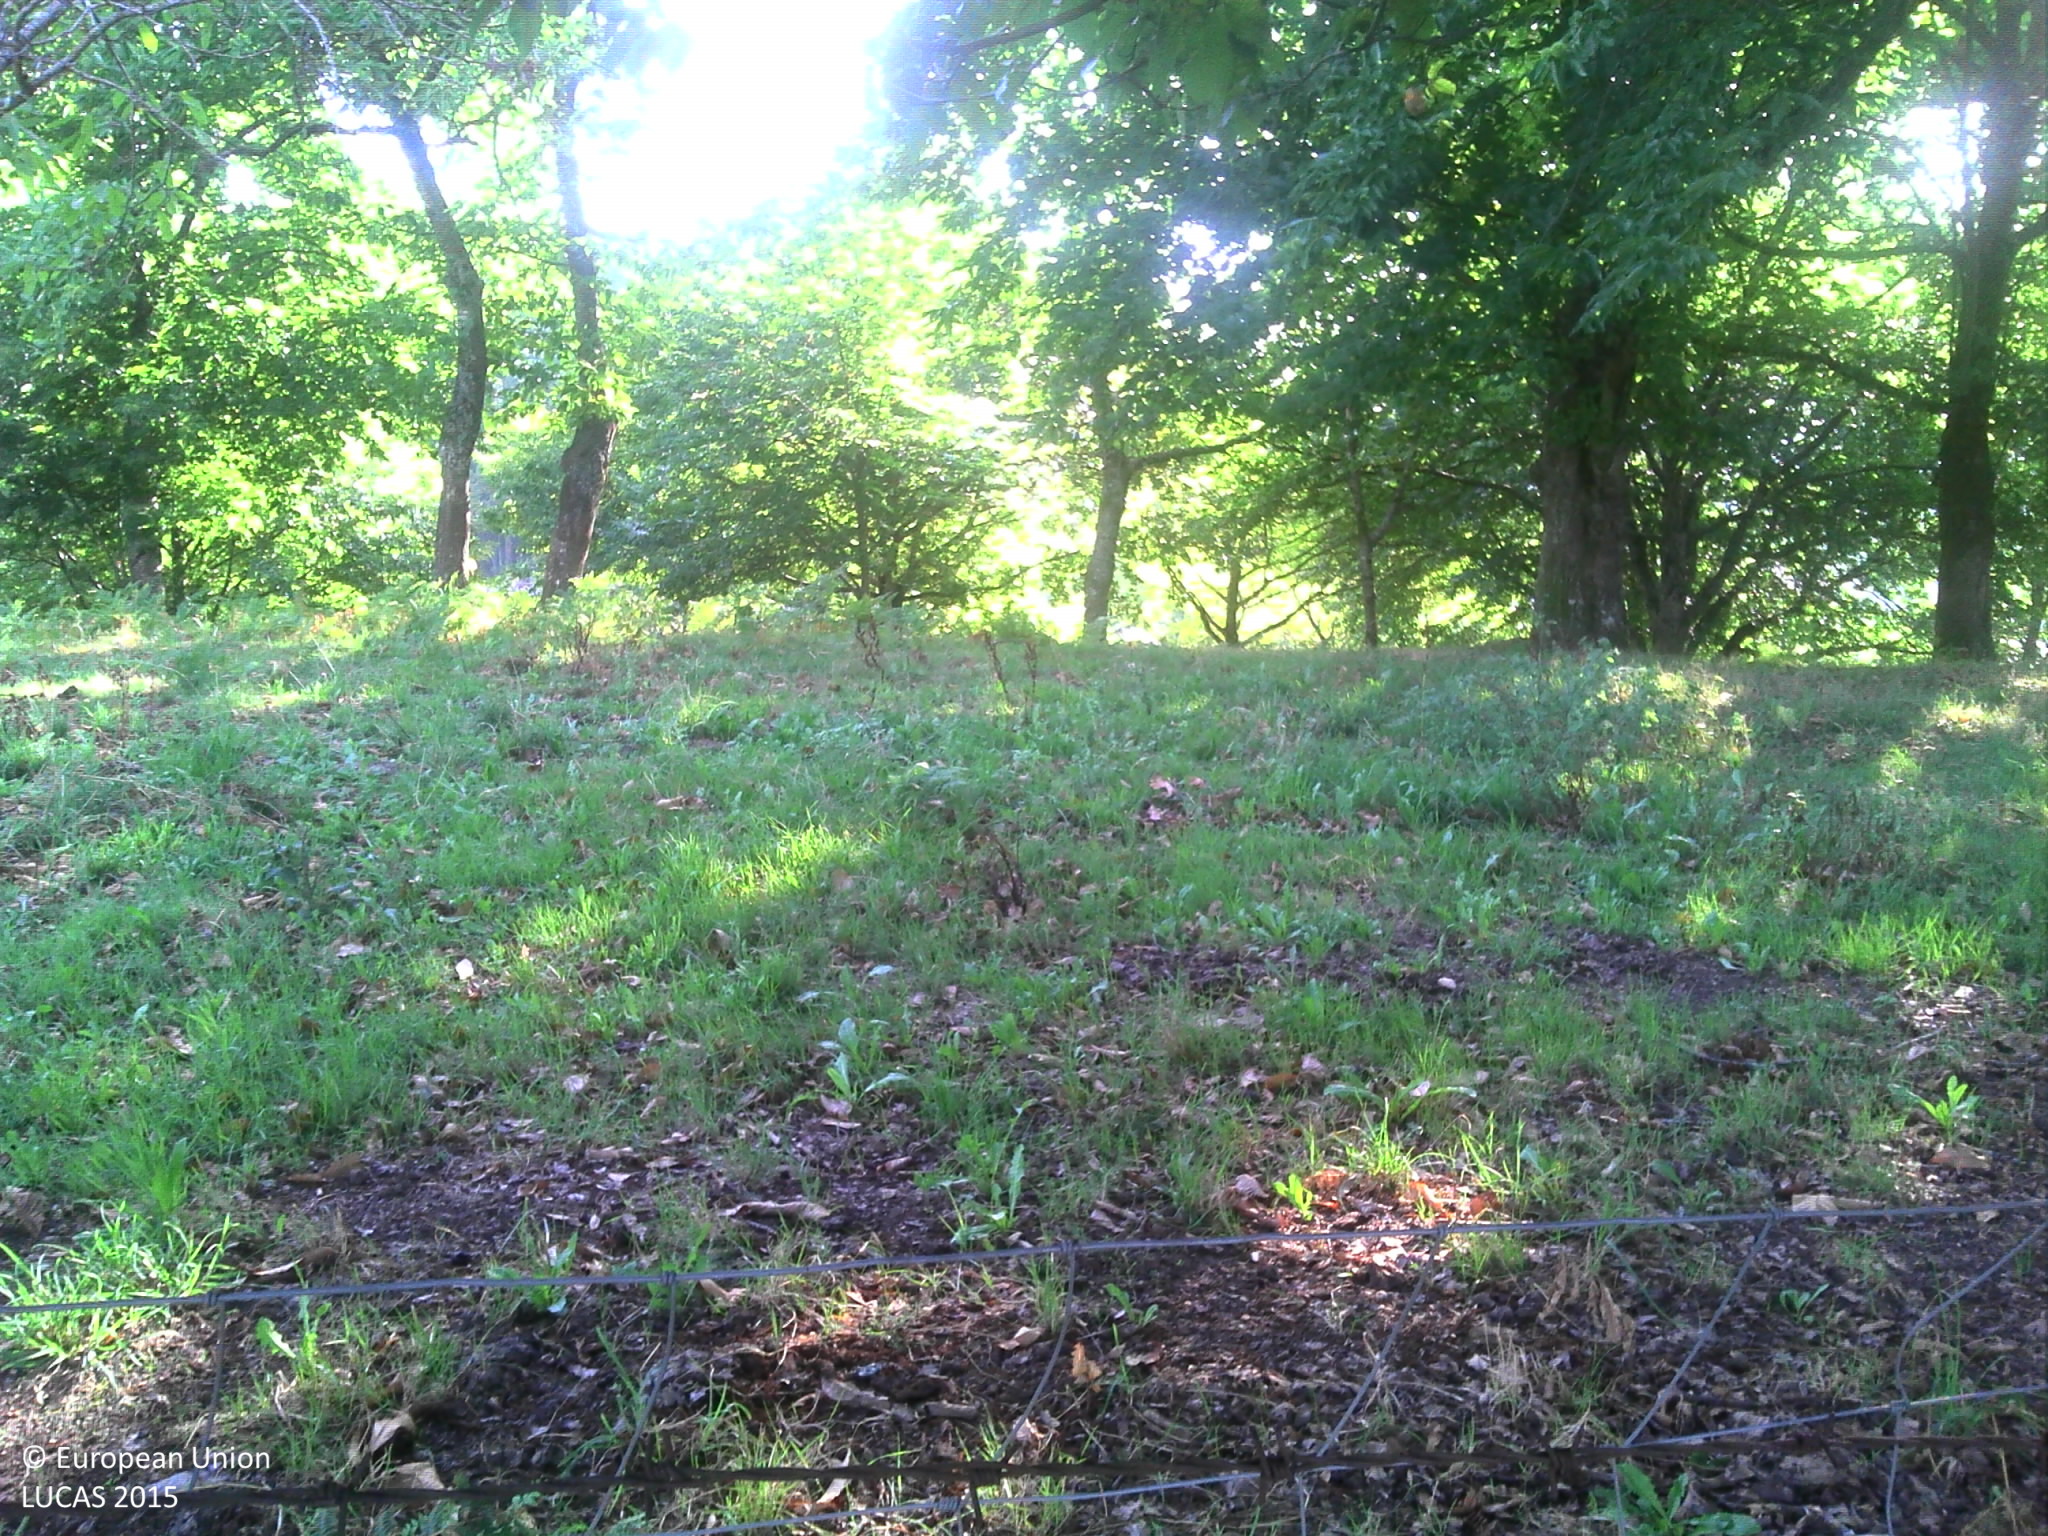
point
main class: Woodland
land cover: Broadleaved woodland
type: thermophilous deciduous forest
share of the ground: 25 - 50 %
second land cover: Grassland without tree/shrub cover
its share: > 75 %
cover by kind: herbaceous plants 60 %, broadleaved forest trees 40 %
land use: Forestry
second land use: Agriculture (excluding fallow land and kitchen gardens)
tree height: > 5 m
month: August
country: FR
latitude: 45.2892
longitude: 1.5158
